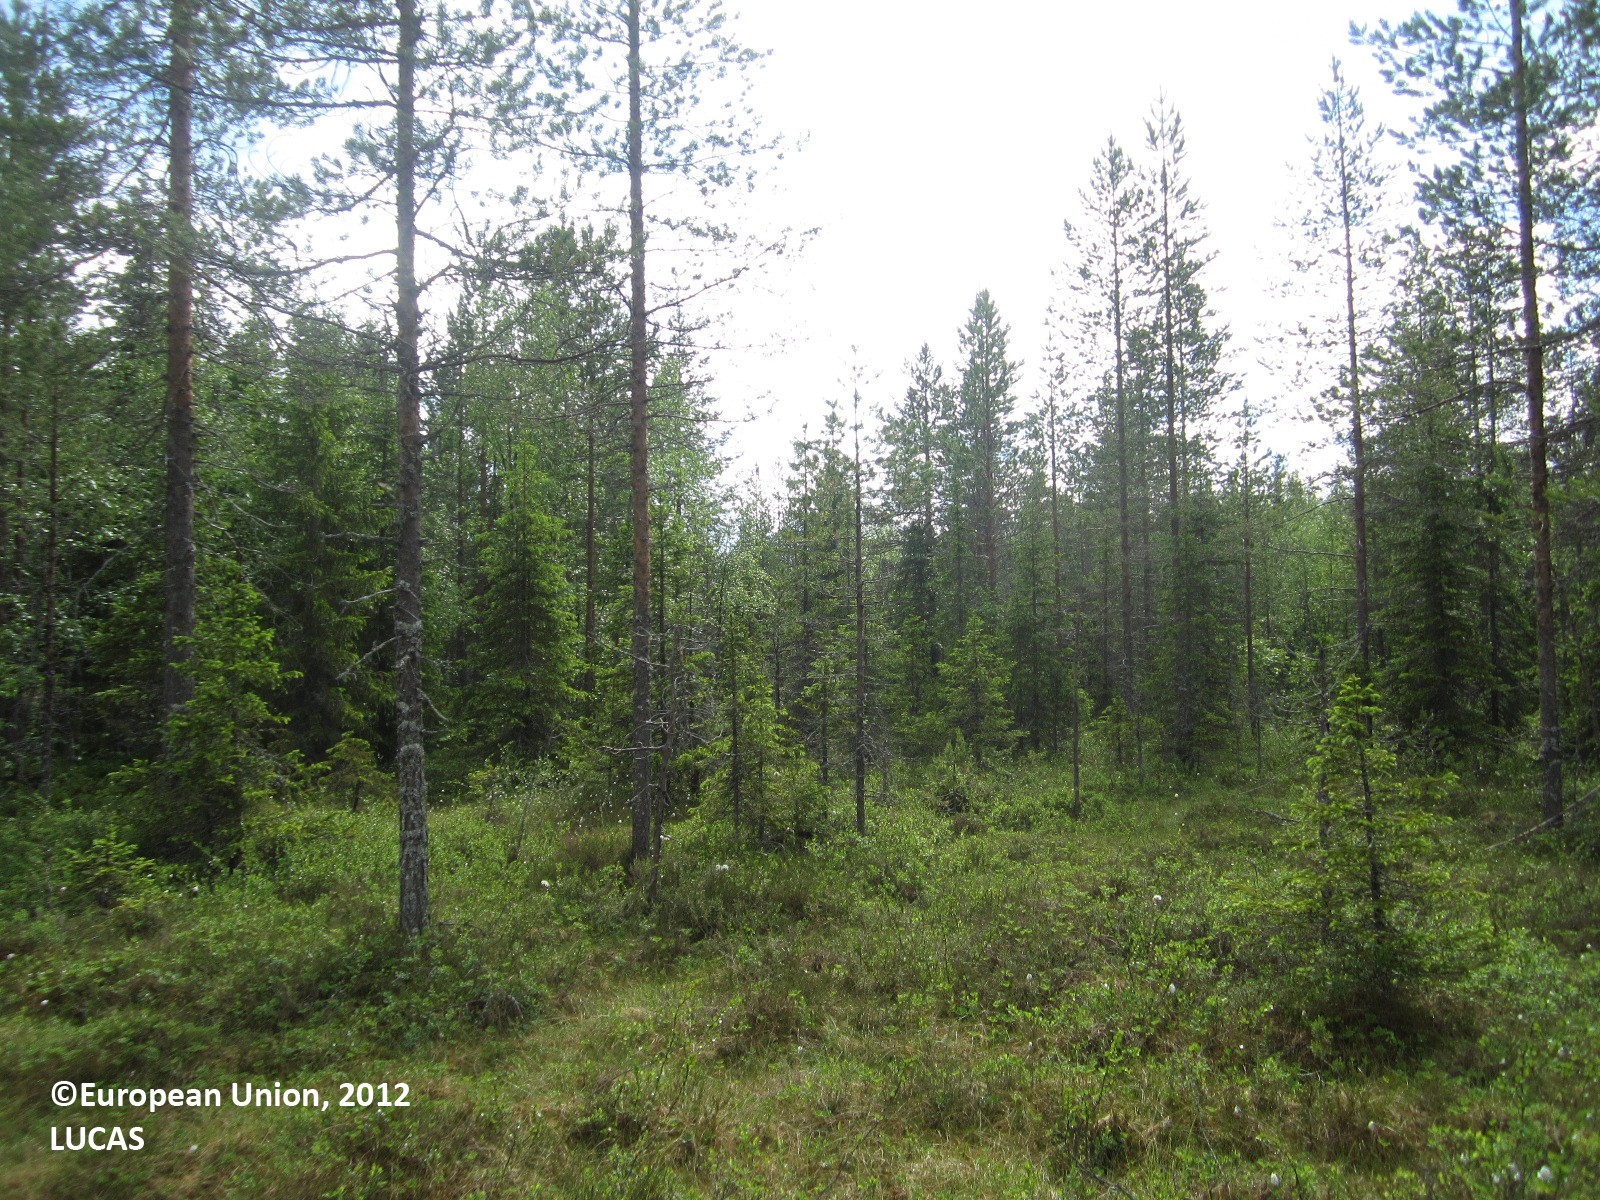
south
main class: Woodland
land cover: Pine dominated coniferous woodland
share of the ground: 10 - 25 %
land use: Semi-natural and natural areas not in use
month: June
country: FI
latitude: 64.6393
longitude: 29.8752
